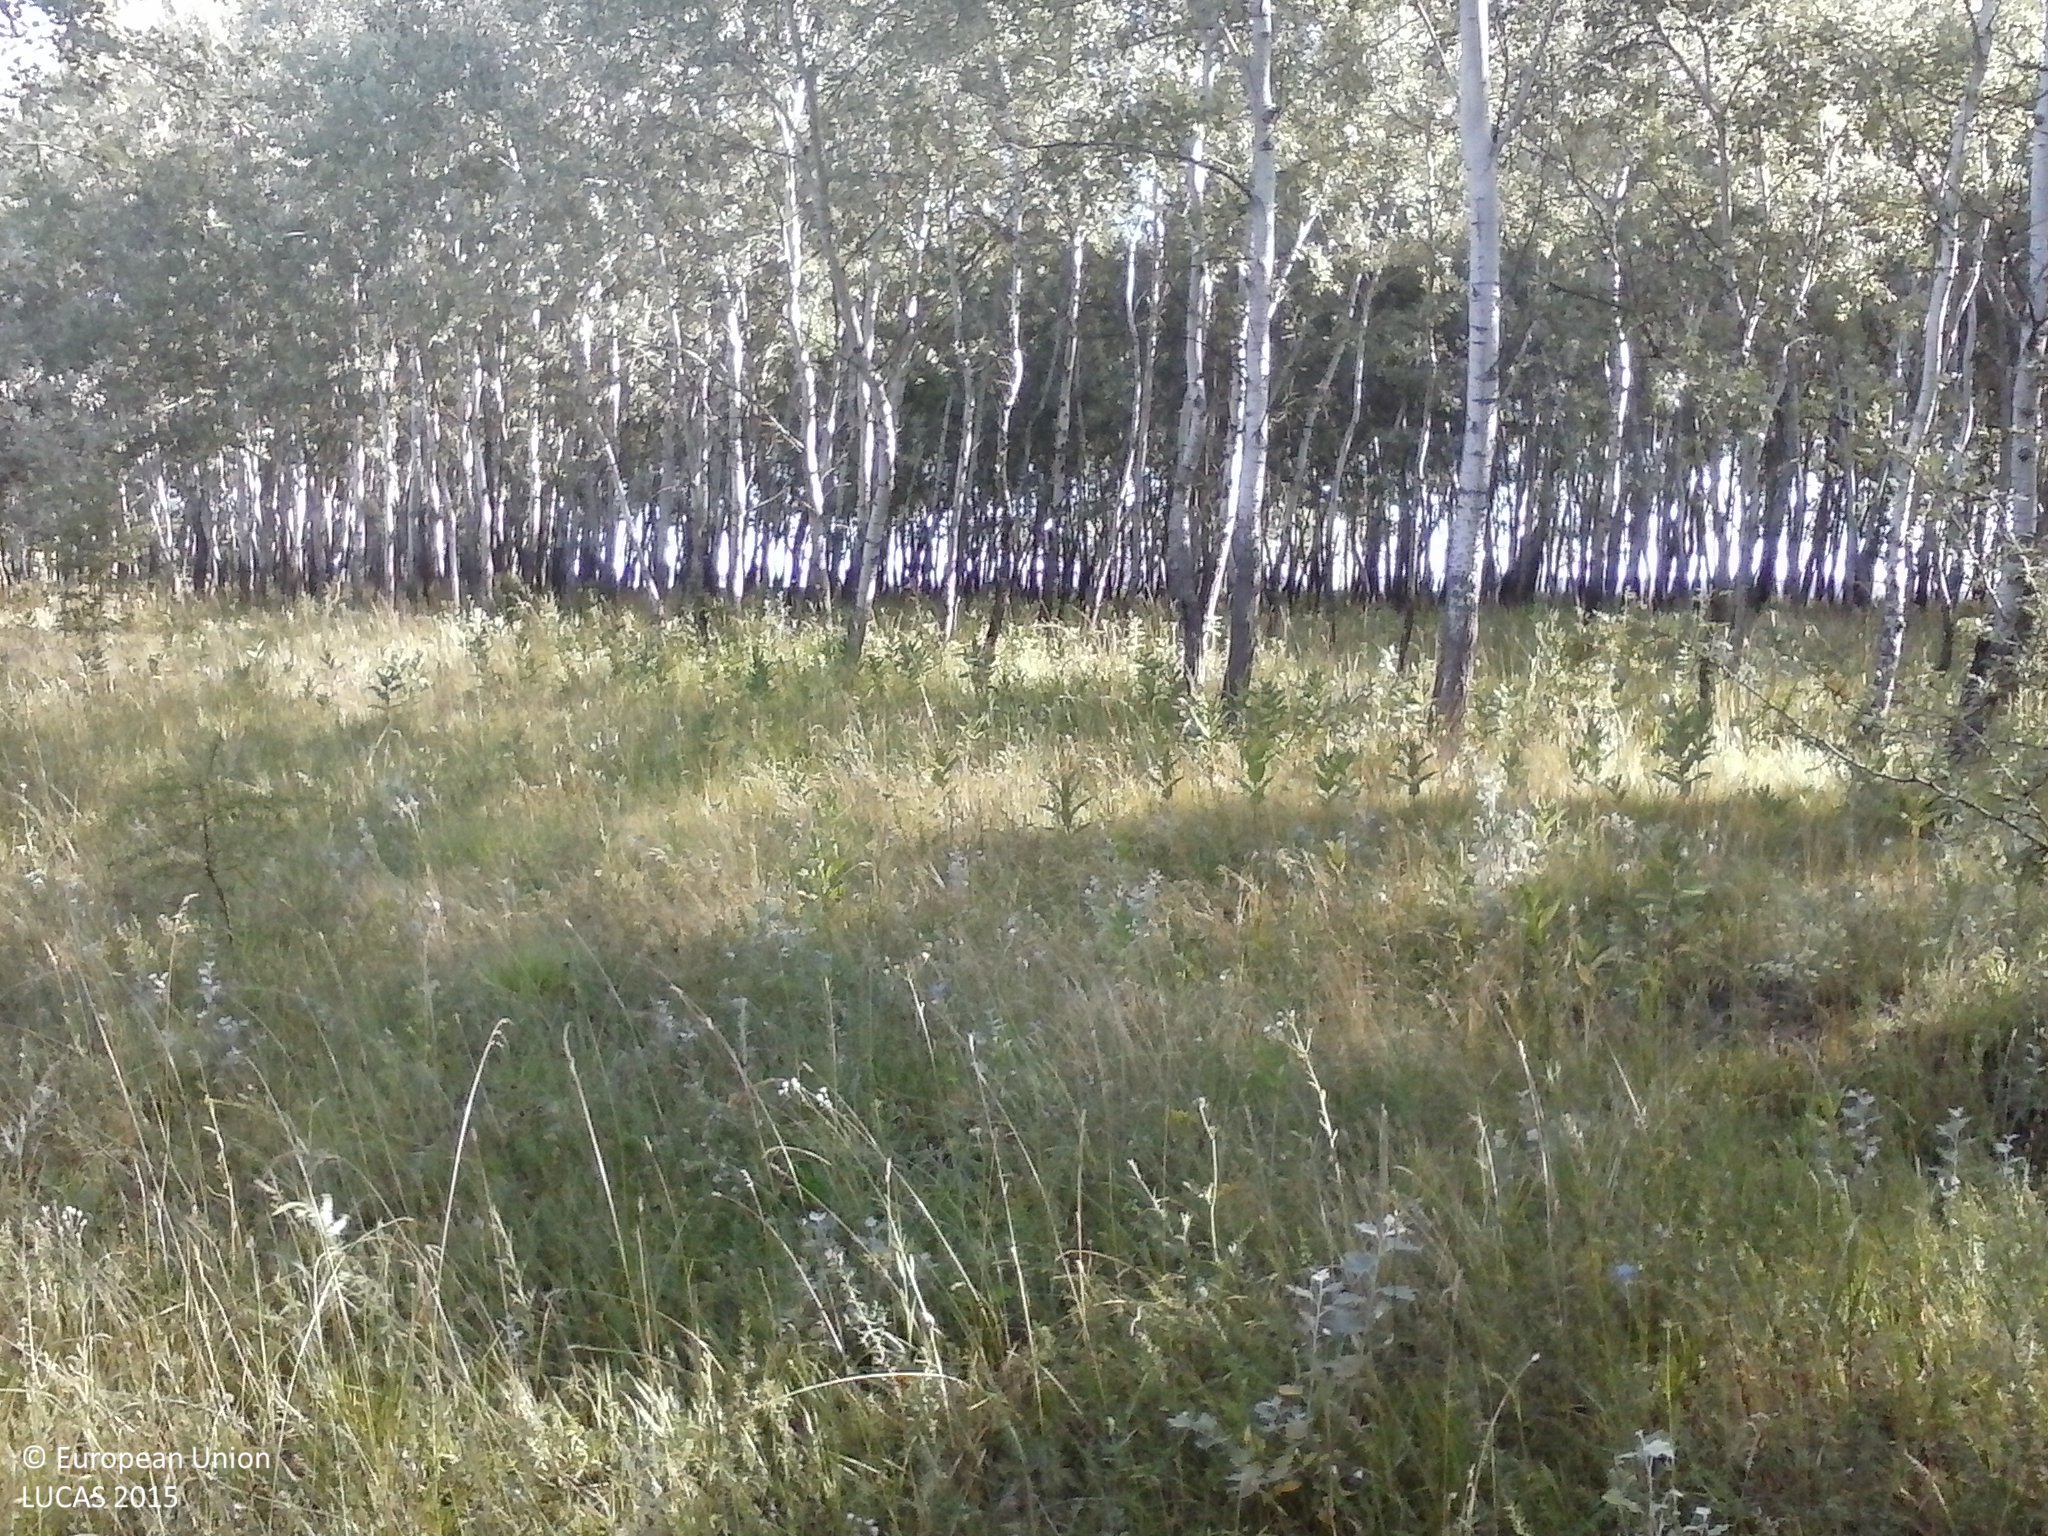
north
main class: Woodland
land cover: Broadleaved woodland
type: non-riverine alder, birch or aspen forest
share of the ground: > 75 %
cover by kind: broadleaved forest trees 80 %, herbaceous plants 15 %, shrubs 5 %
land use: Forestry
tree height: > 5 m
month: July
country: HU
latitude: 46.3789
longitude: 19.5211
